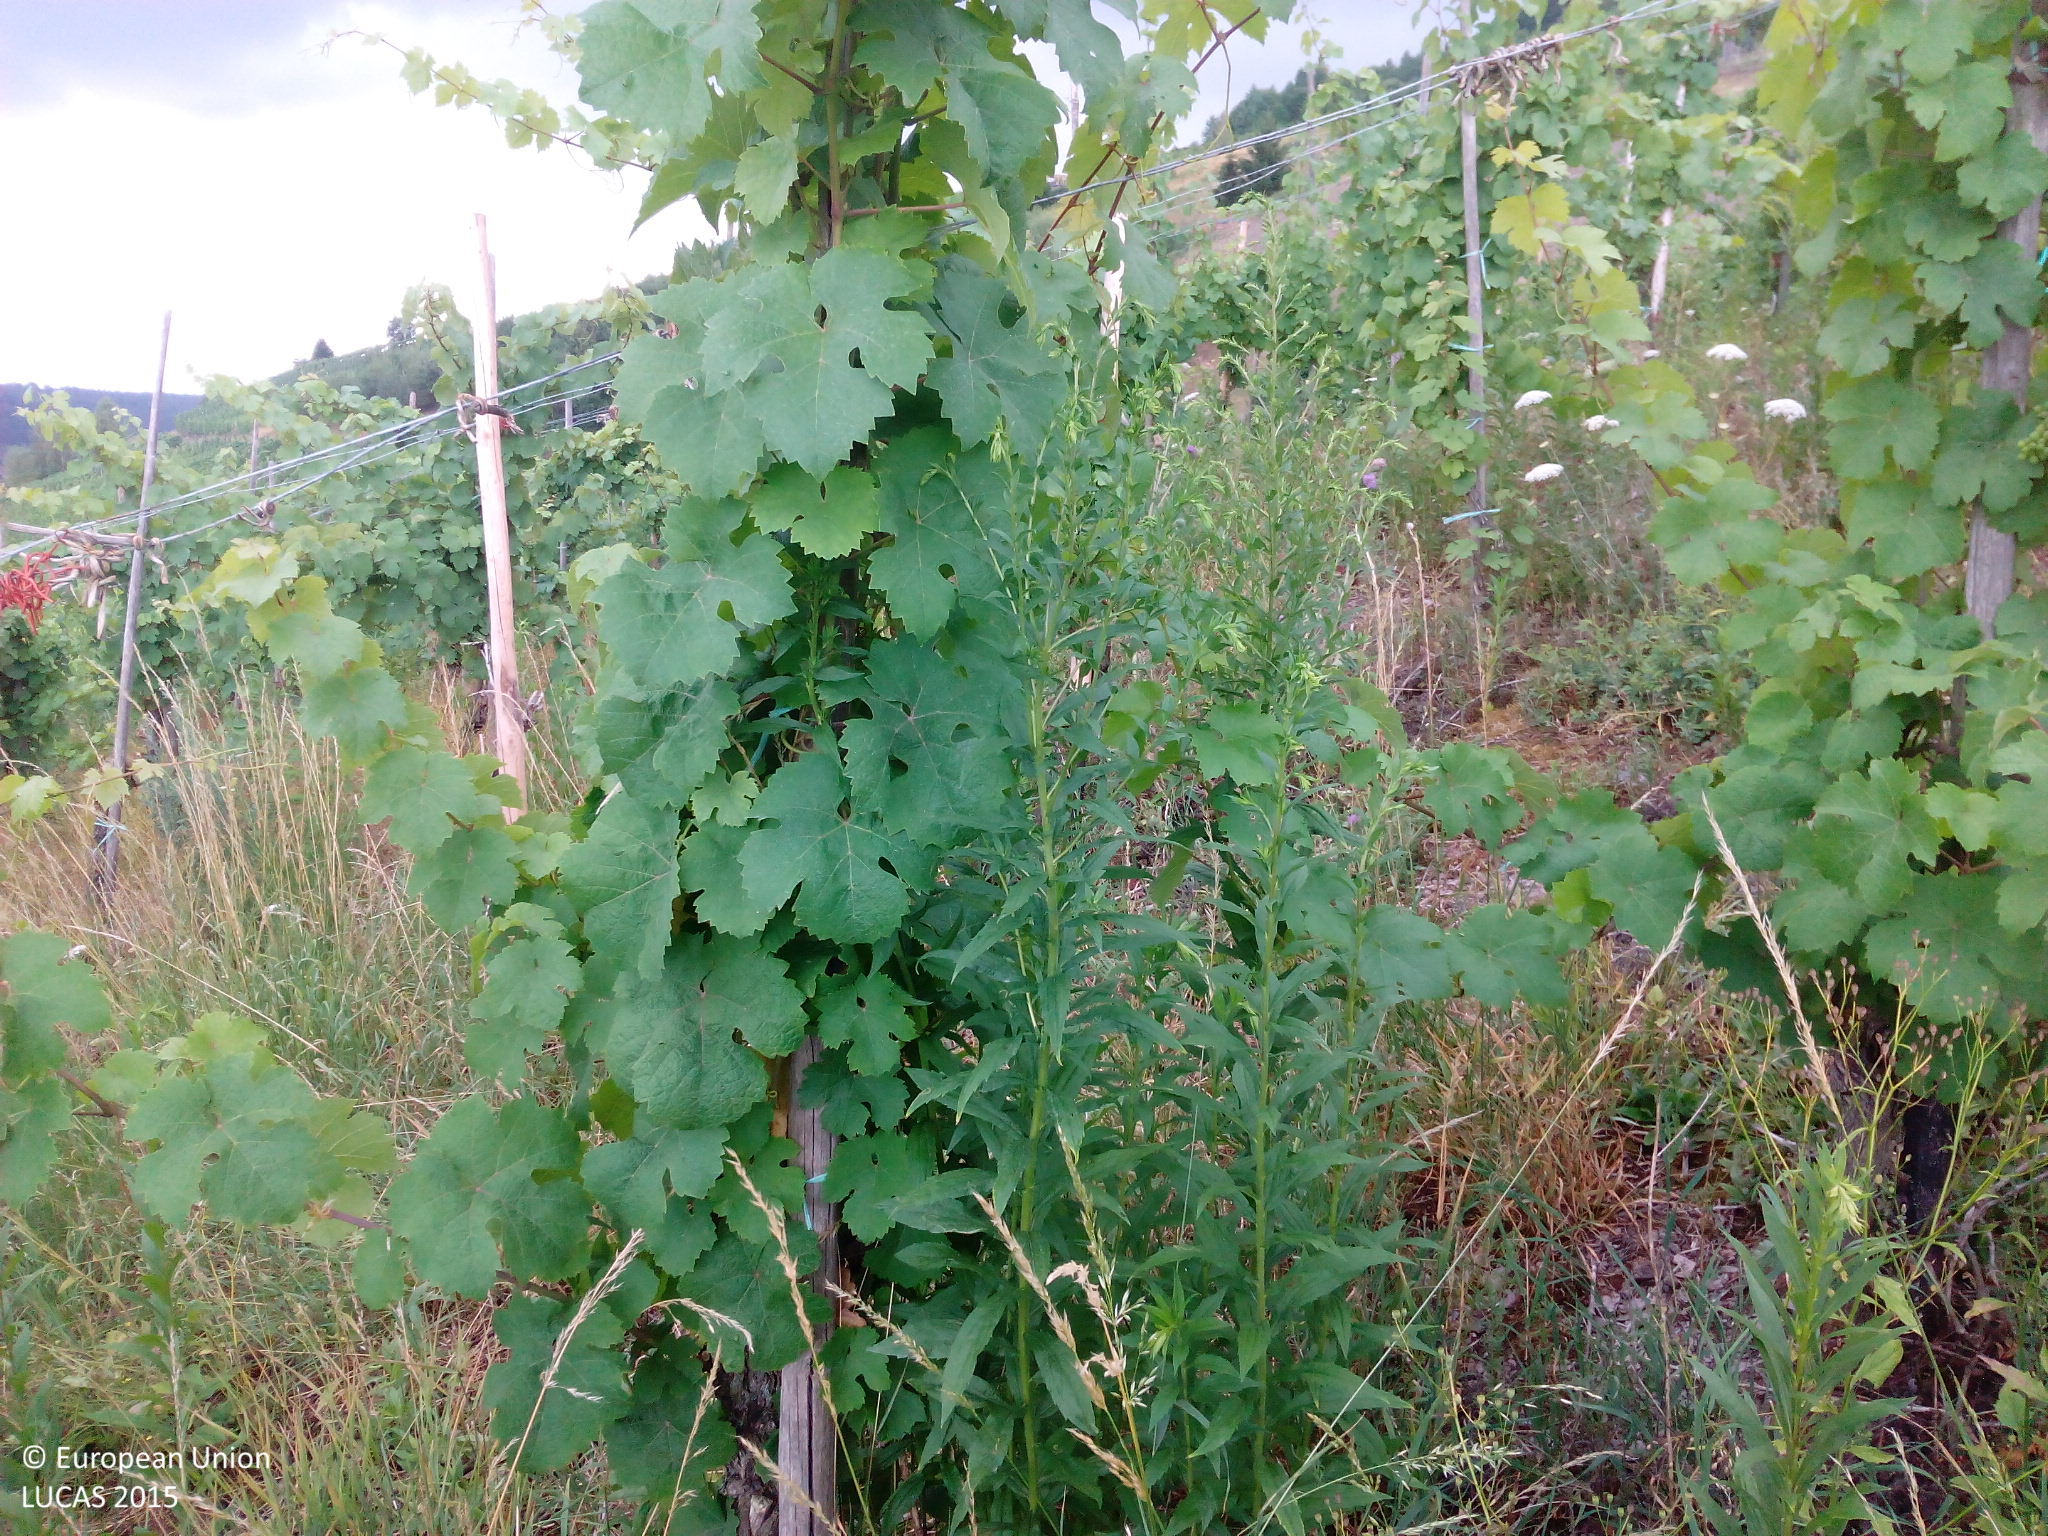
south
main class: Cropland
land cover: Vineyards
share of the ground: > 75 %
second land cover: Spontaneously vegetated surfaces
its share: > 75 %
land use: Agriculture (excluding fallow land and kitchen gardens)
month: July
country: DE
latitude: 50.0217
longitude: 7.1110
